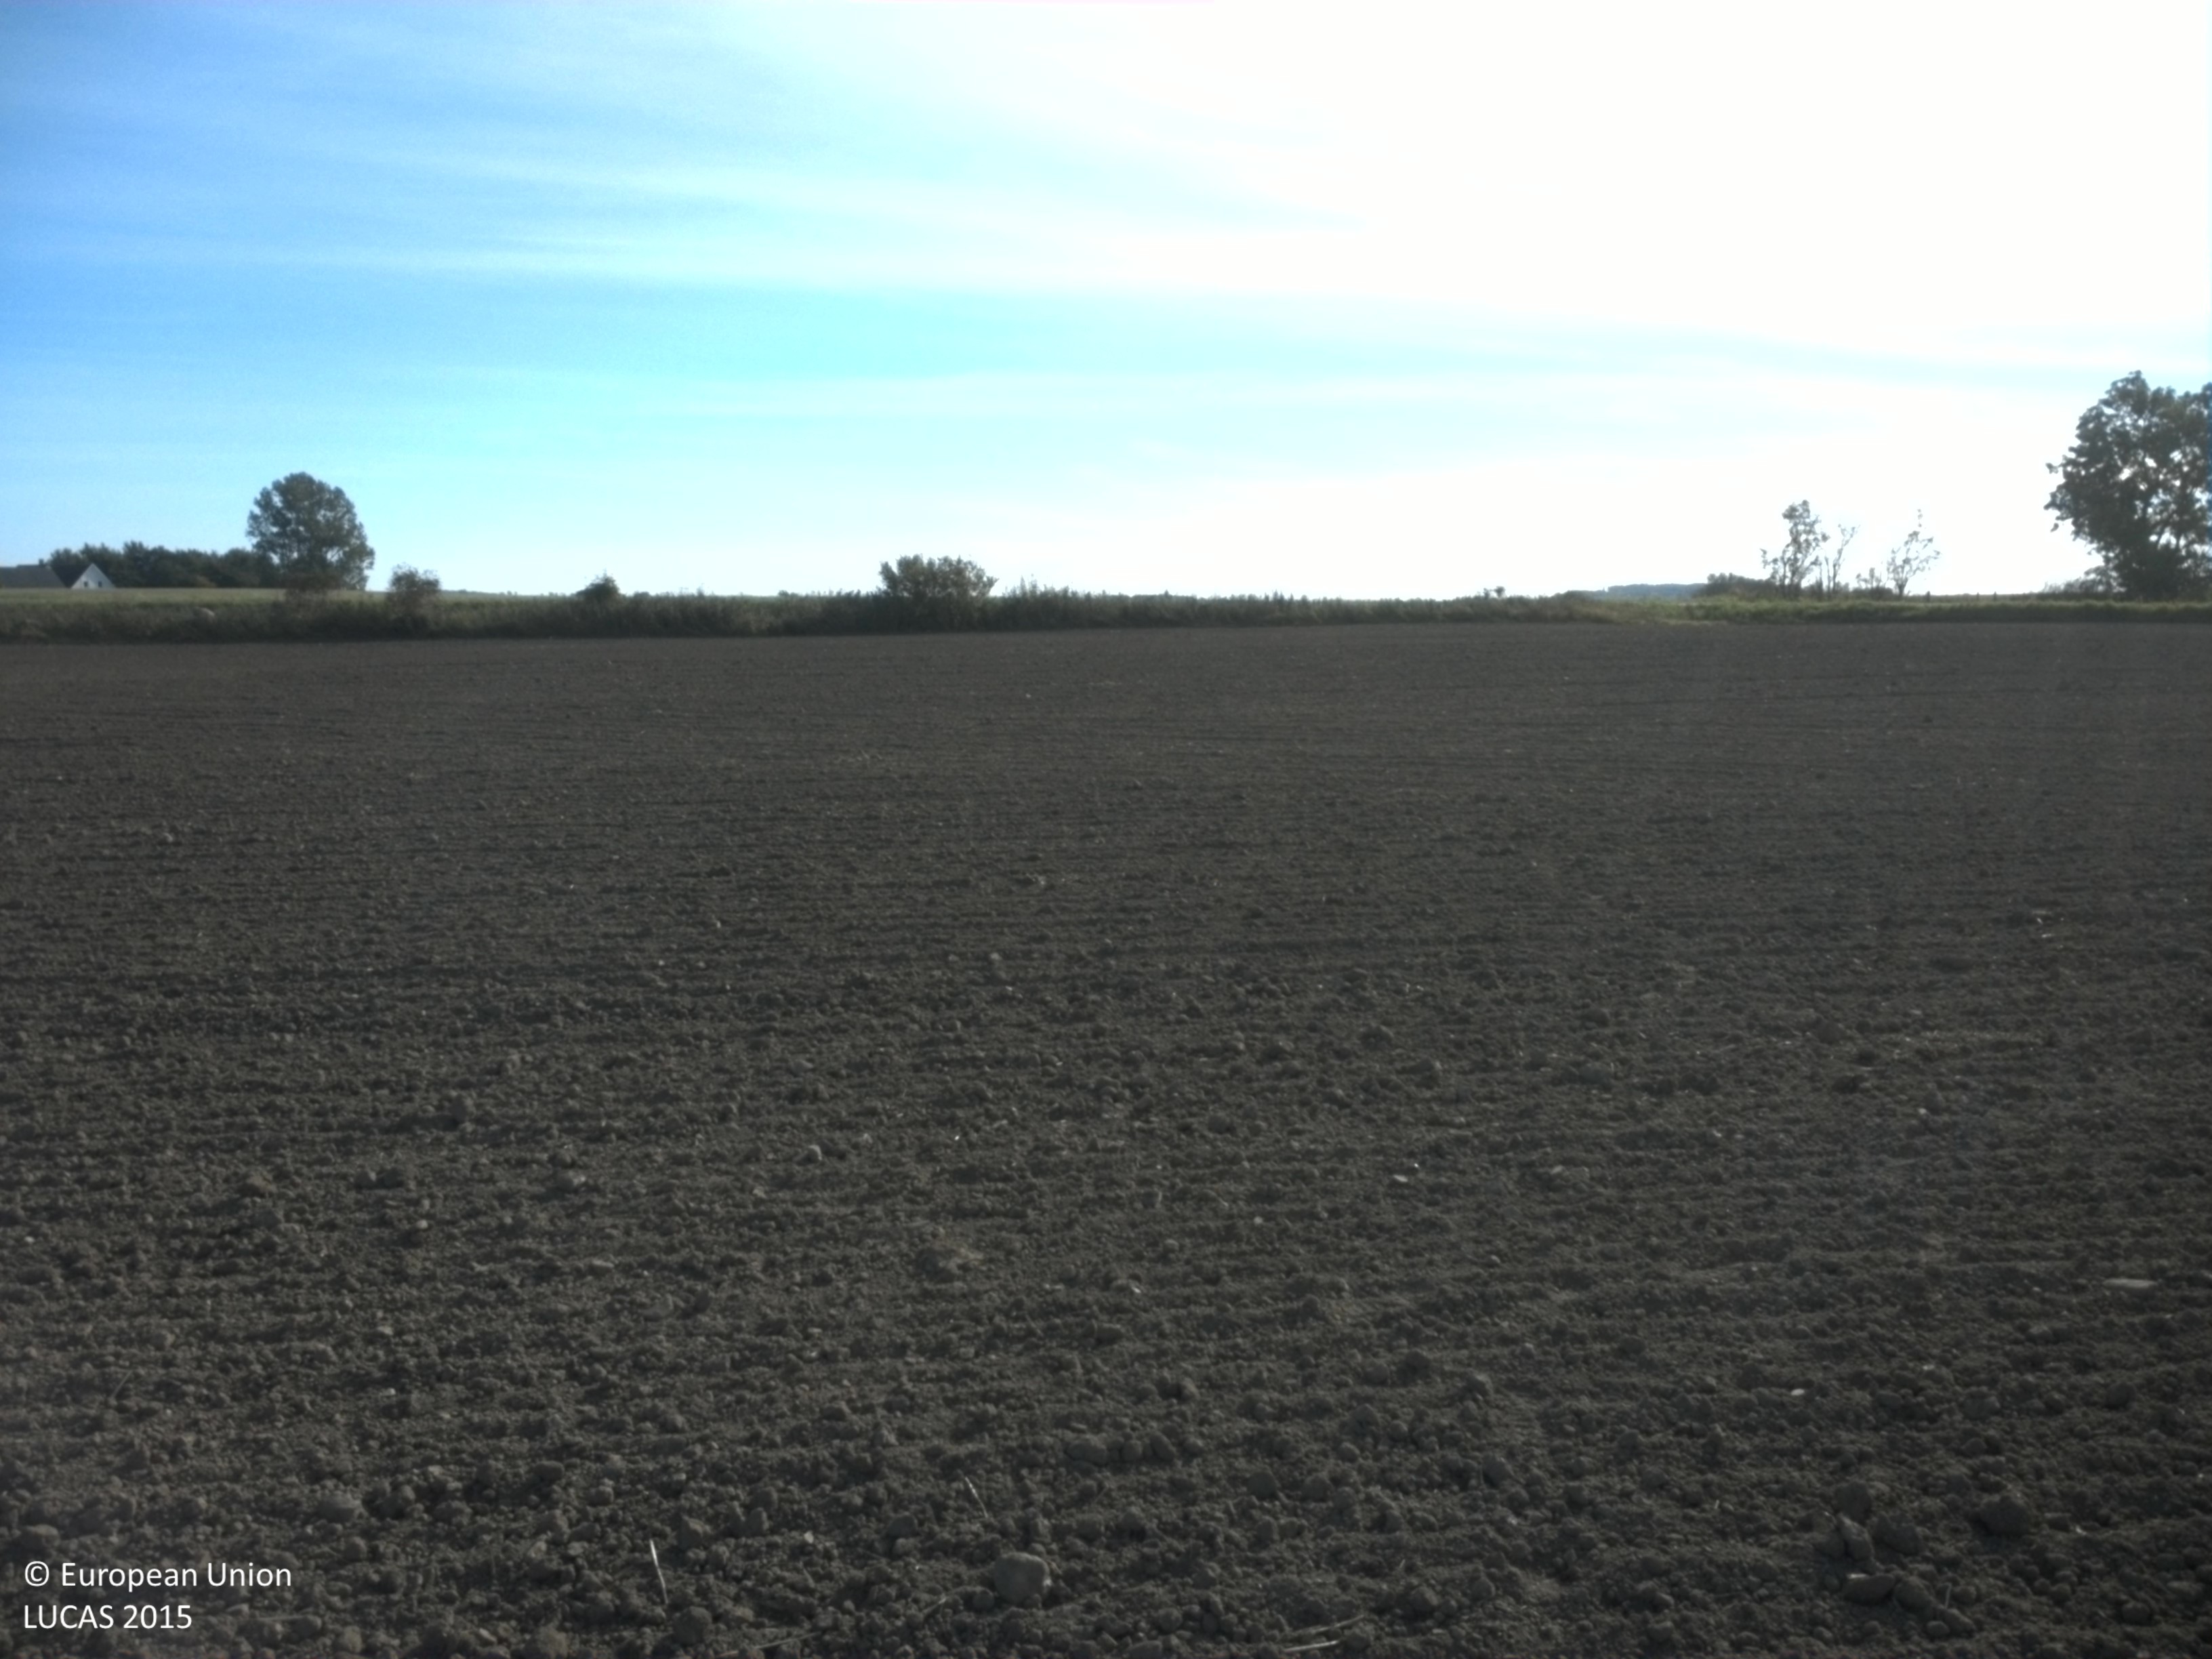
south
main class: Cropland
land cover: Common wheat
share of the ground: < 10 %
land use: Agriculture (excluding fallow land and kitchen gardens)
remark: Tilled/Sowed
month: October
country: SE
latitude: 55.7024
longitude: 13.7057
